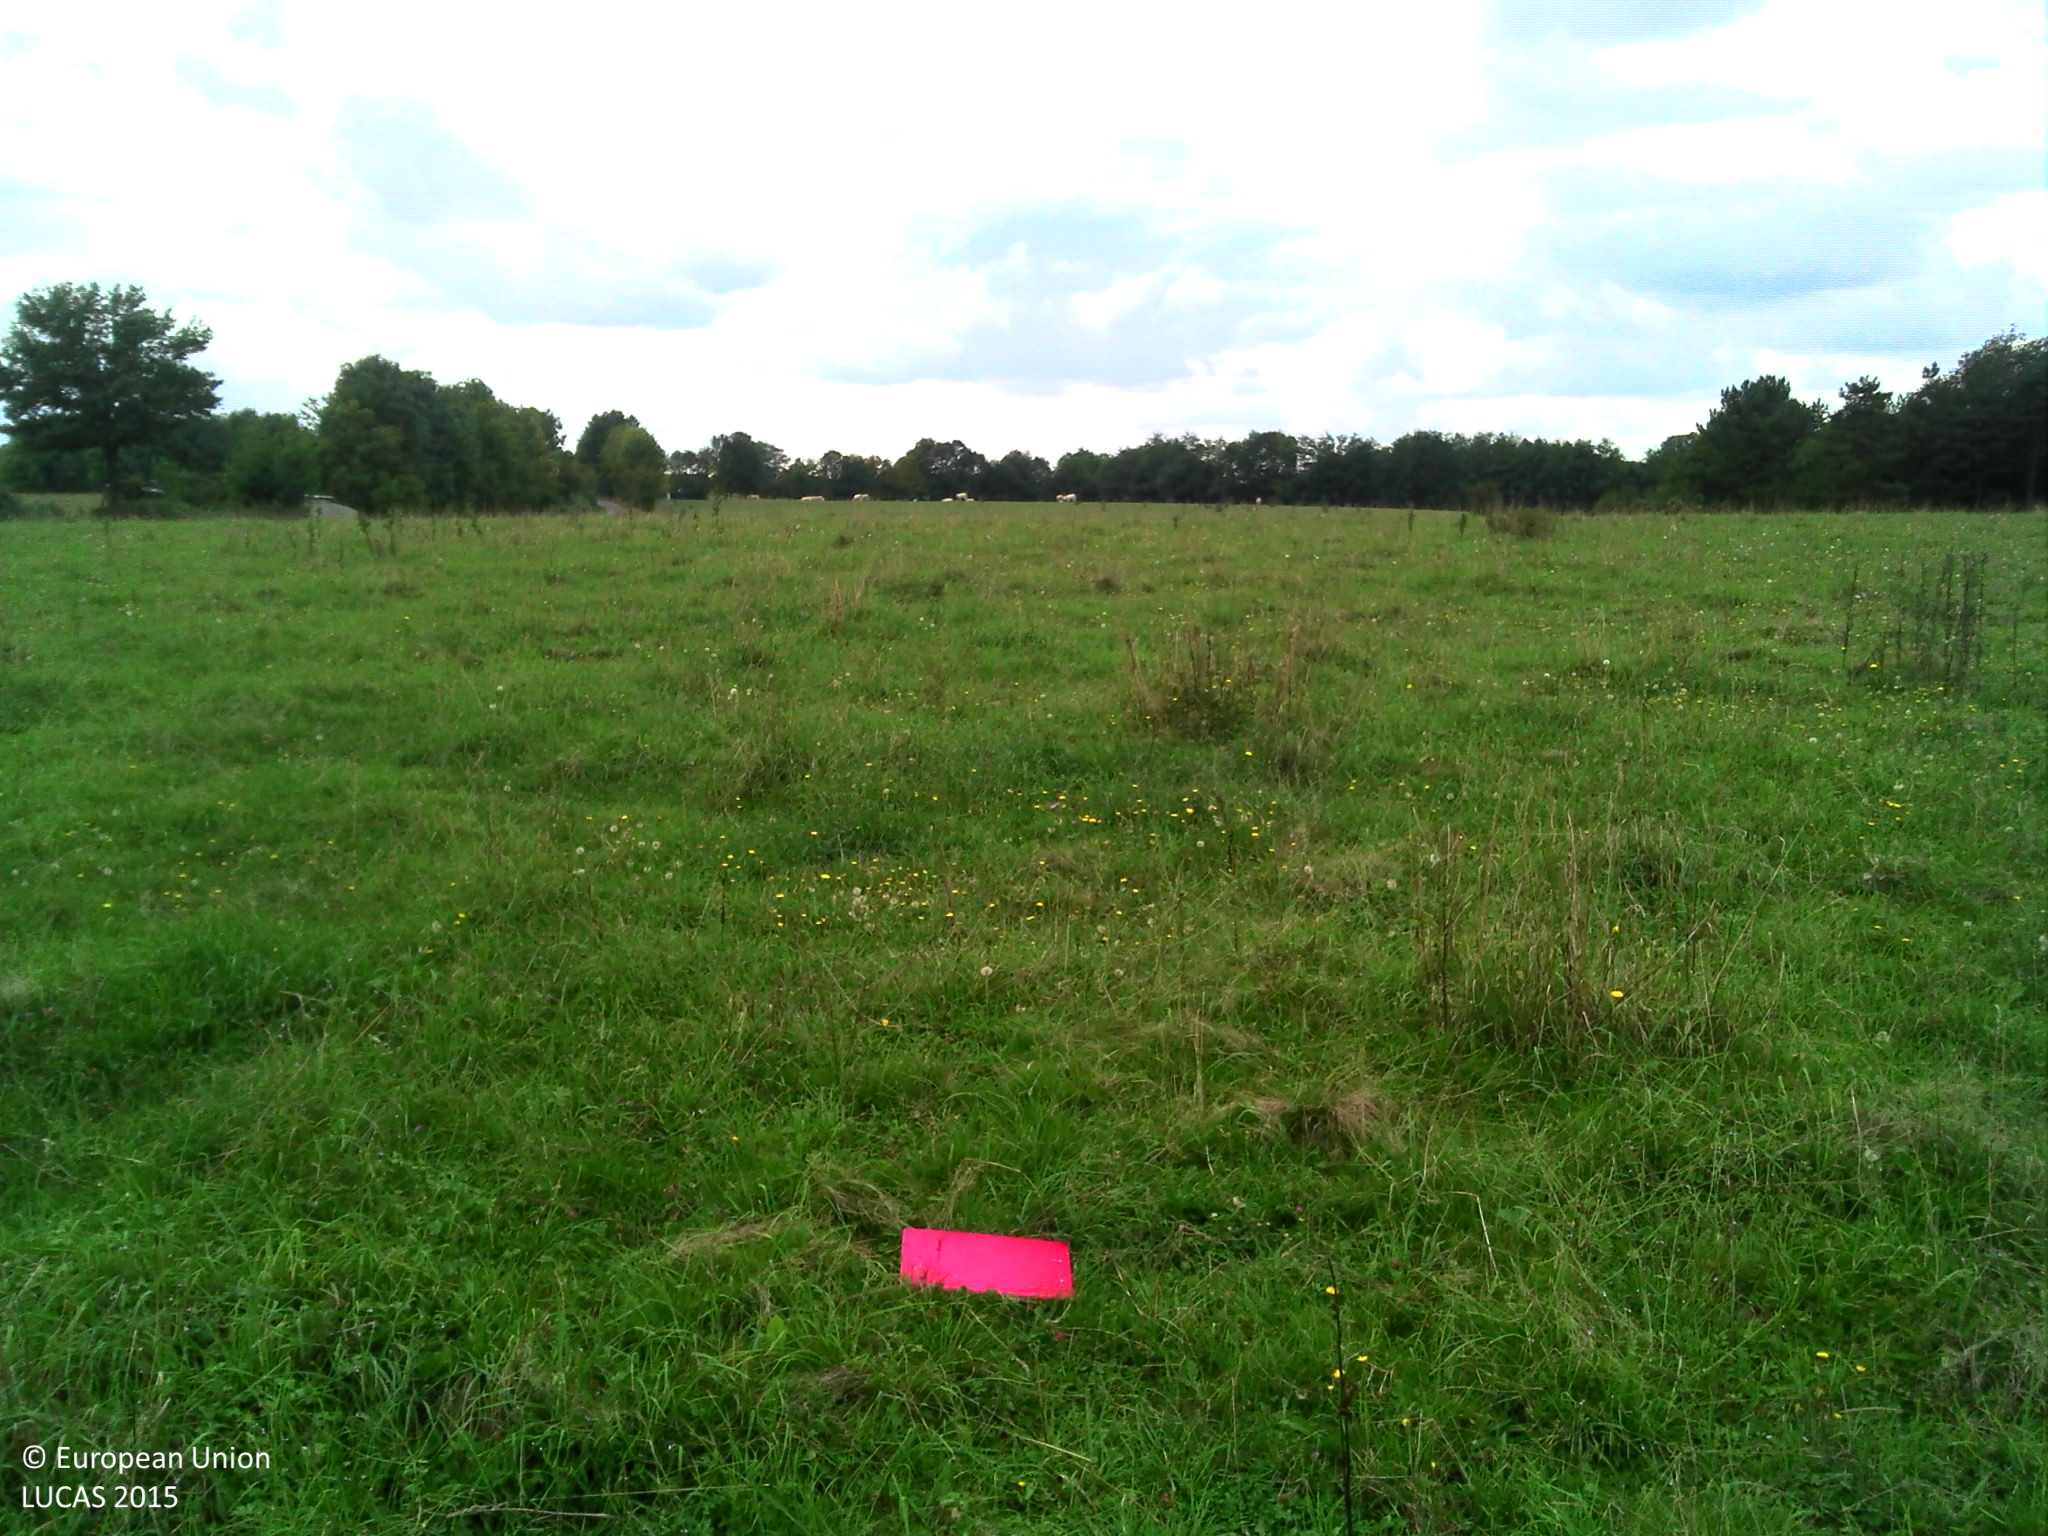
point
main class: Grassland
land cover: Grassland without tree/shrub cover
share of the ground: > 75 %
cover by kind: herbaceous plants 100 %
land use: Agriculture (excluding fallow land and kitchen gardens)
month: September
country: FR
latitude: 43.4136
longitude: -0.1700
